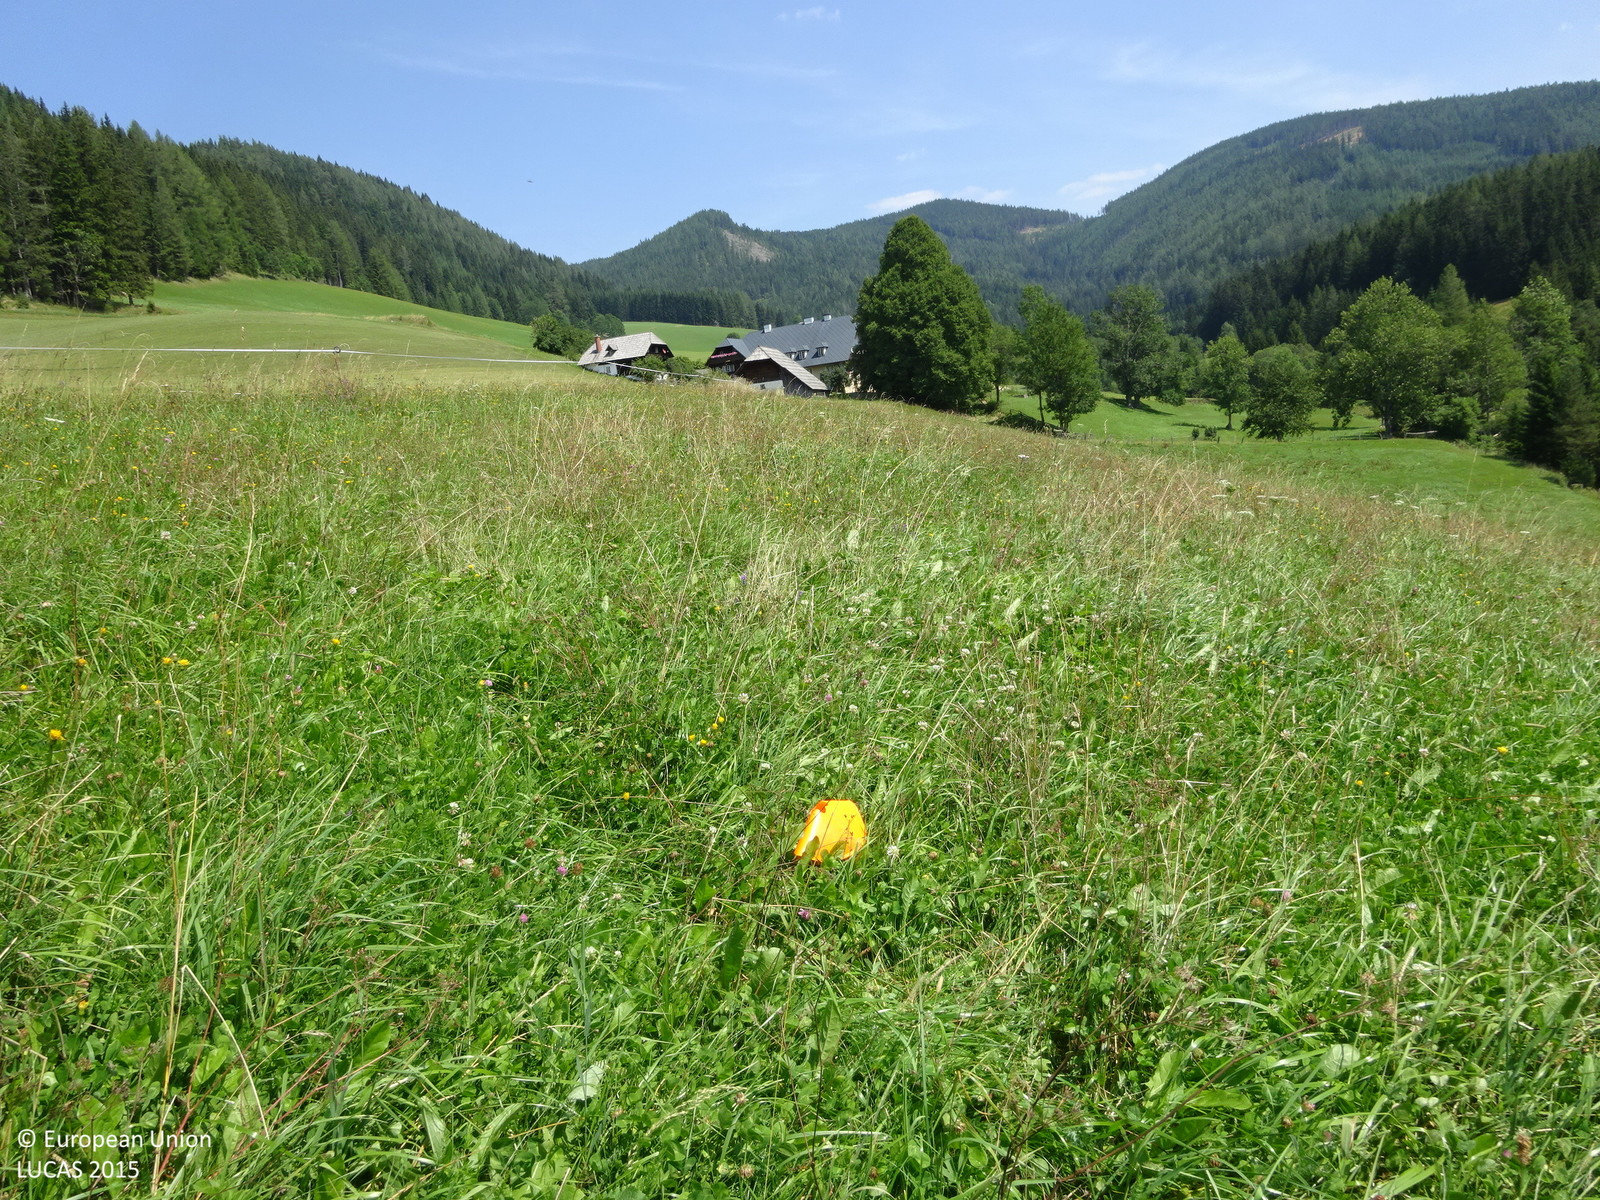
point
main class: Grassland
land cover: Grassland without tree/shrub cover
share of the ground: > 75 %
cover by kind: herbaceous plants 100 %
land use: Agriculture (excluding fallow land and kitchen gardens)
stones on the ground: < 10 %
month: August
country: AT
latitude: 47.5292
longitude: 15.8062
